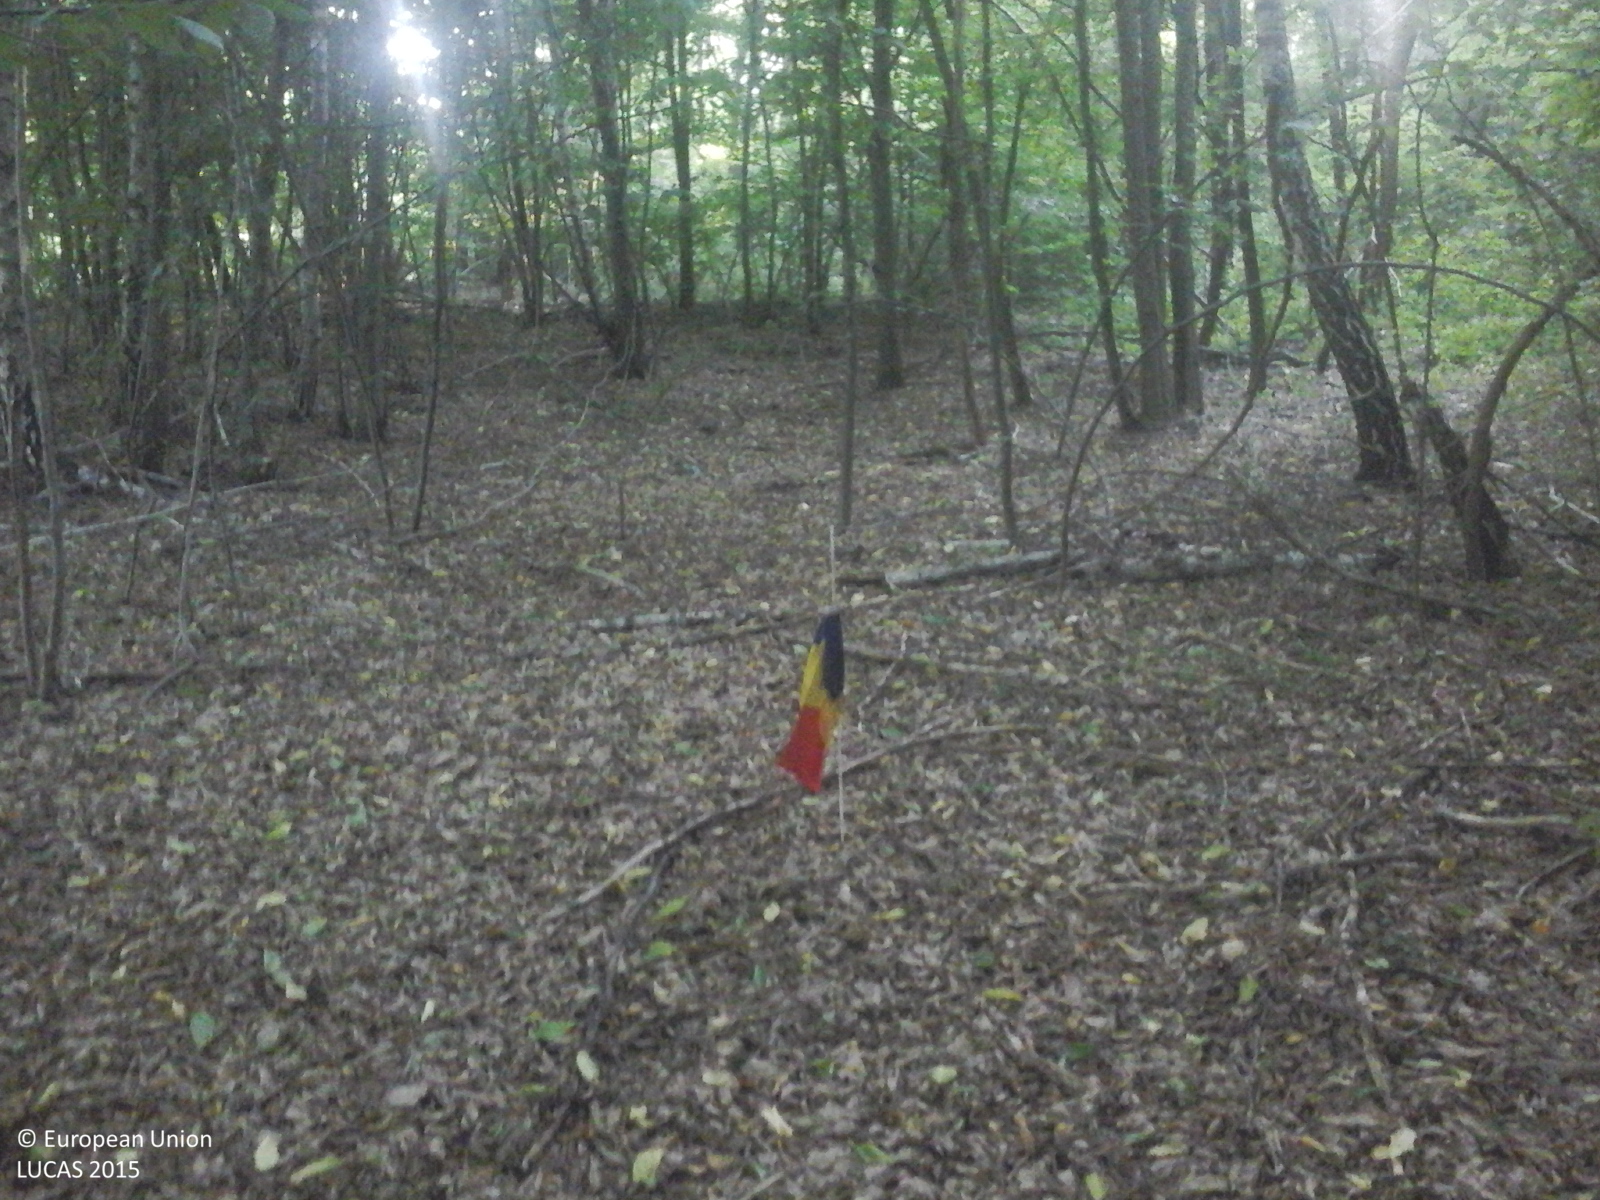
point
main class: Woodland
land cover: Broadleaved woodland
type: beech forest
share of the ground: > 75 %
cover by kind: broadleaved forest trees 100 %
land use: Forestry
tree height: > 5 m
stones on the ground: 10 - 25 %
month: July
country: RO
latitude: 45.0584
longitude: 24.5406
